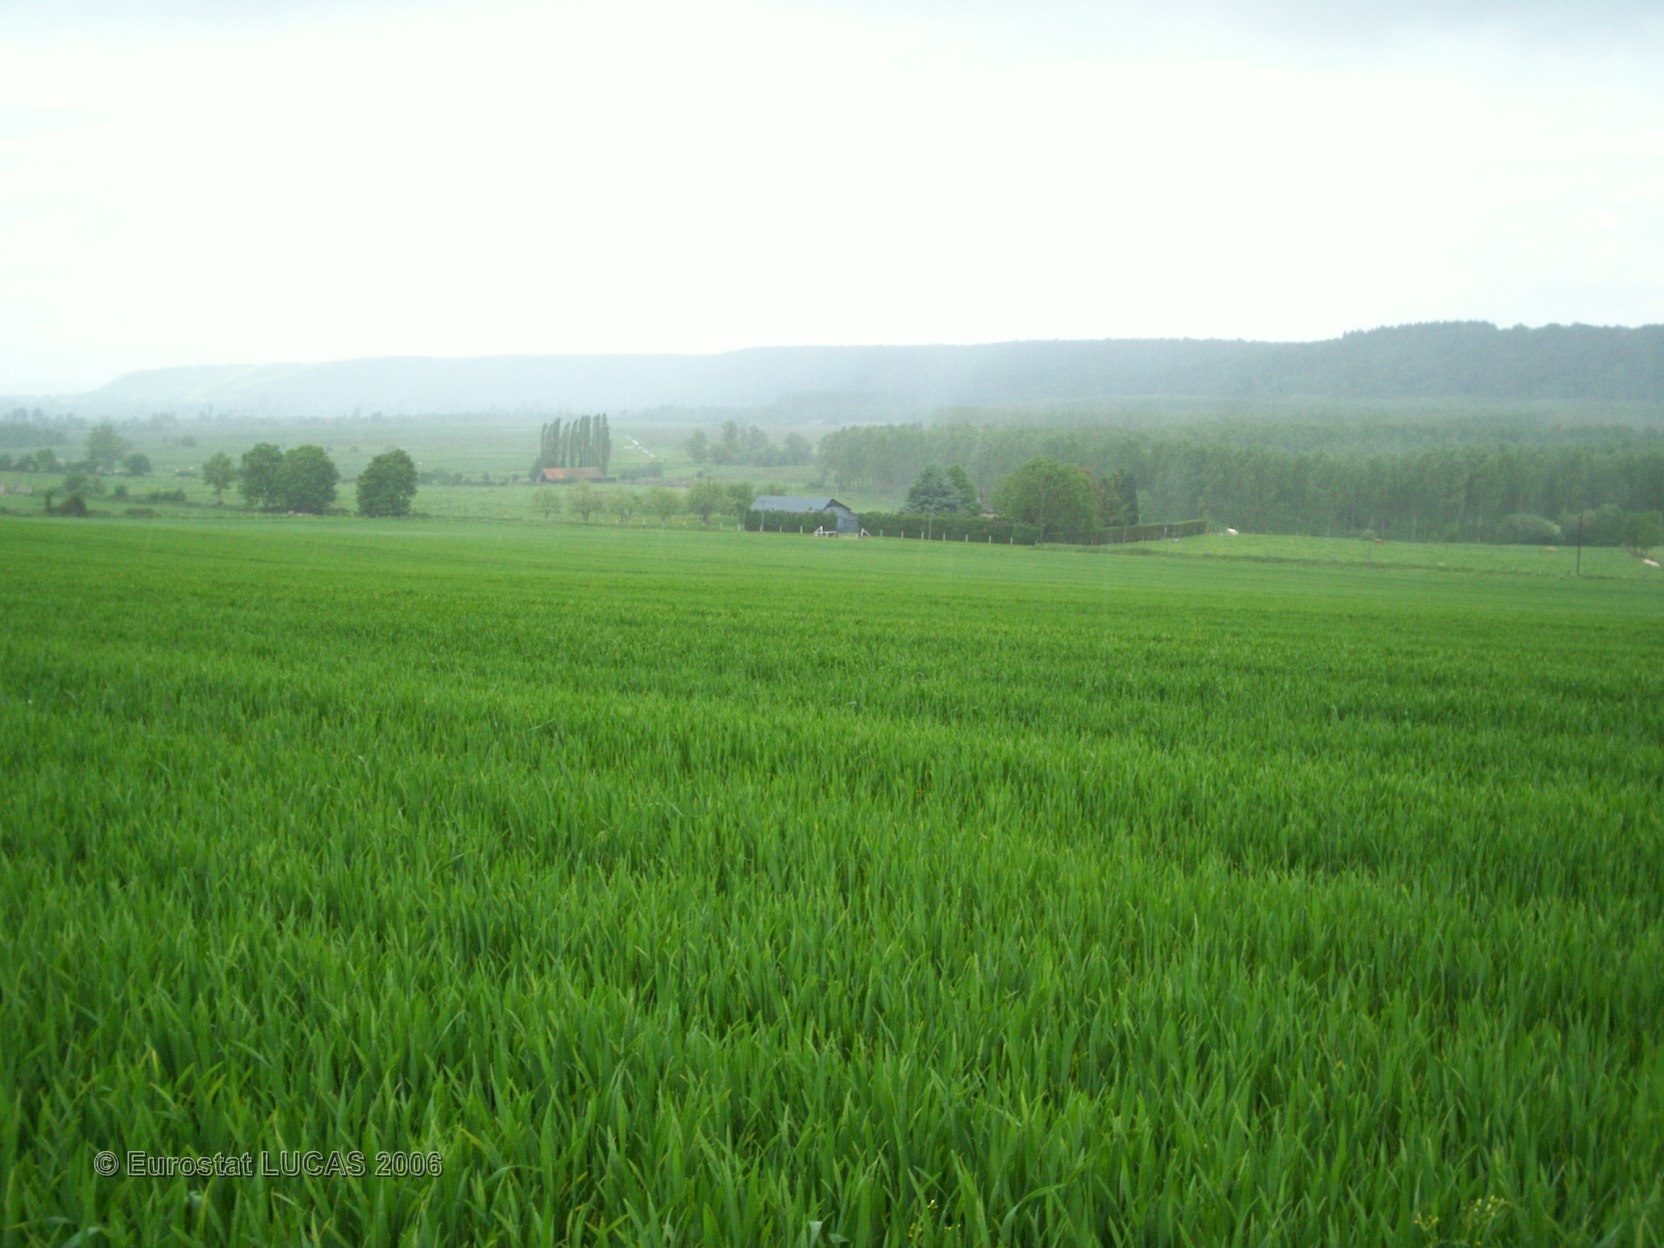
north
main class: Cropland
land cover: Common wheat
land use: Agriculture (excluding fallow land and kitchen gardens)
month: May
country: FR
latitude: 49.3666
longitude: 0.4577
